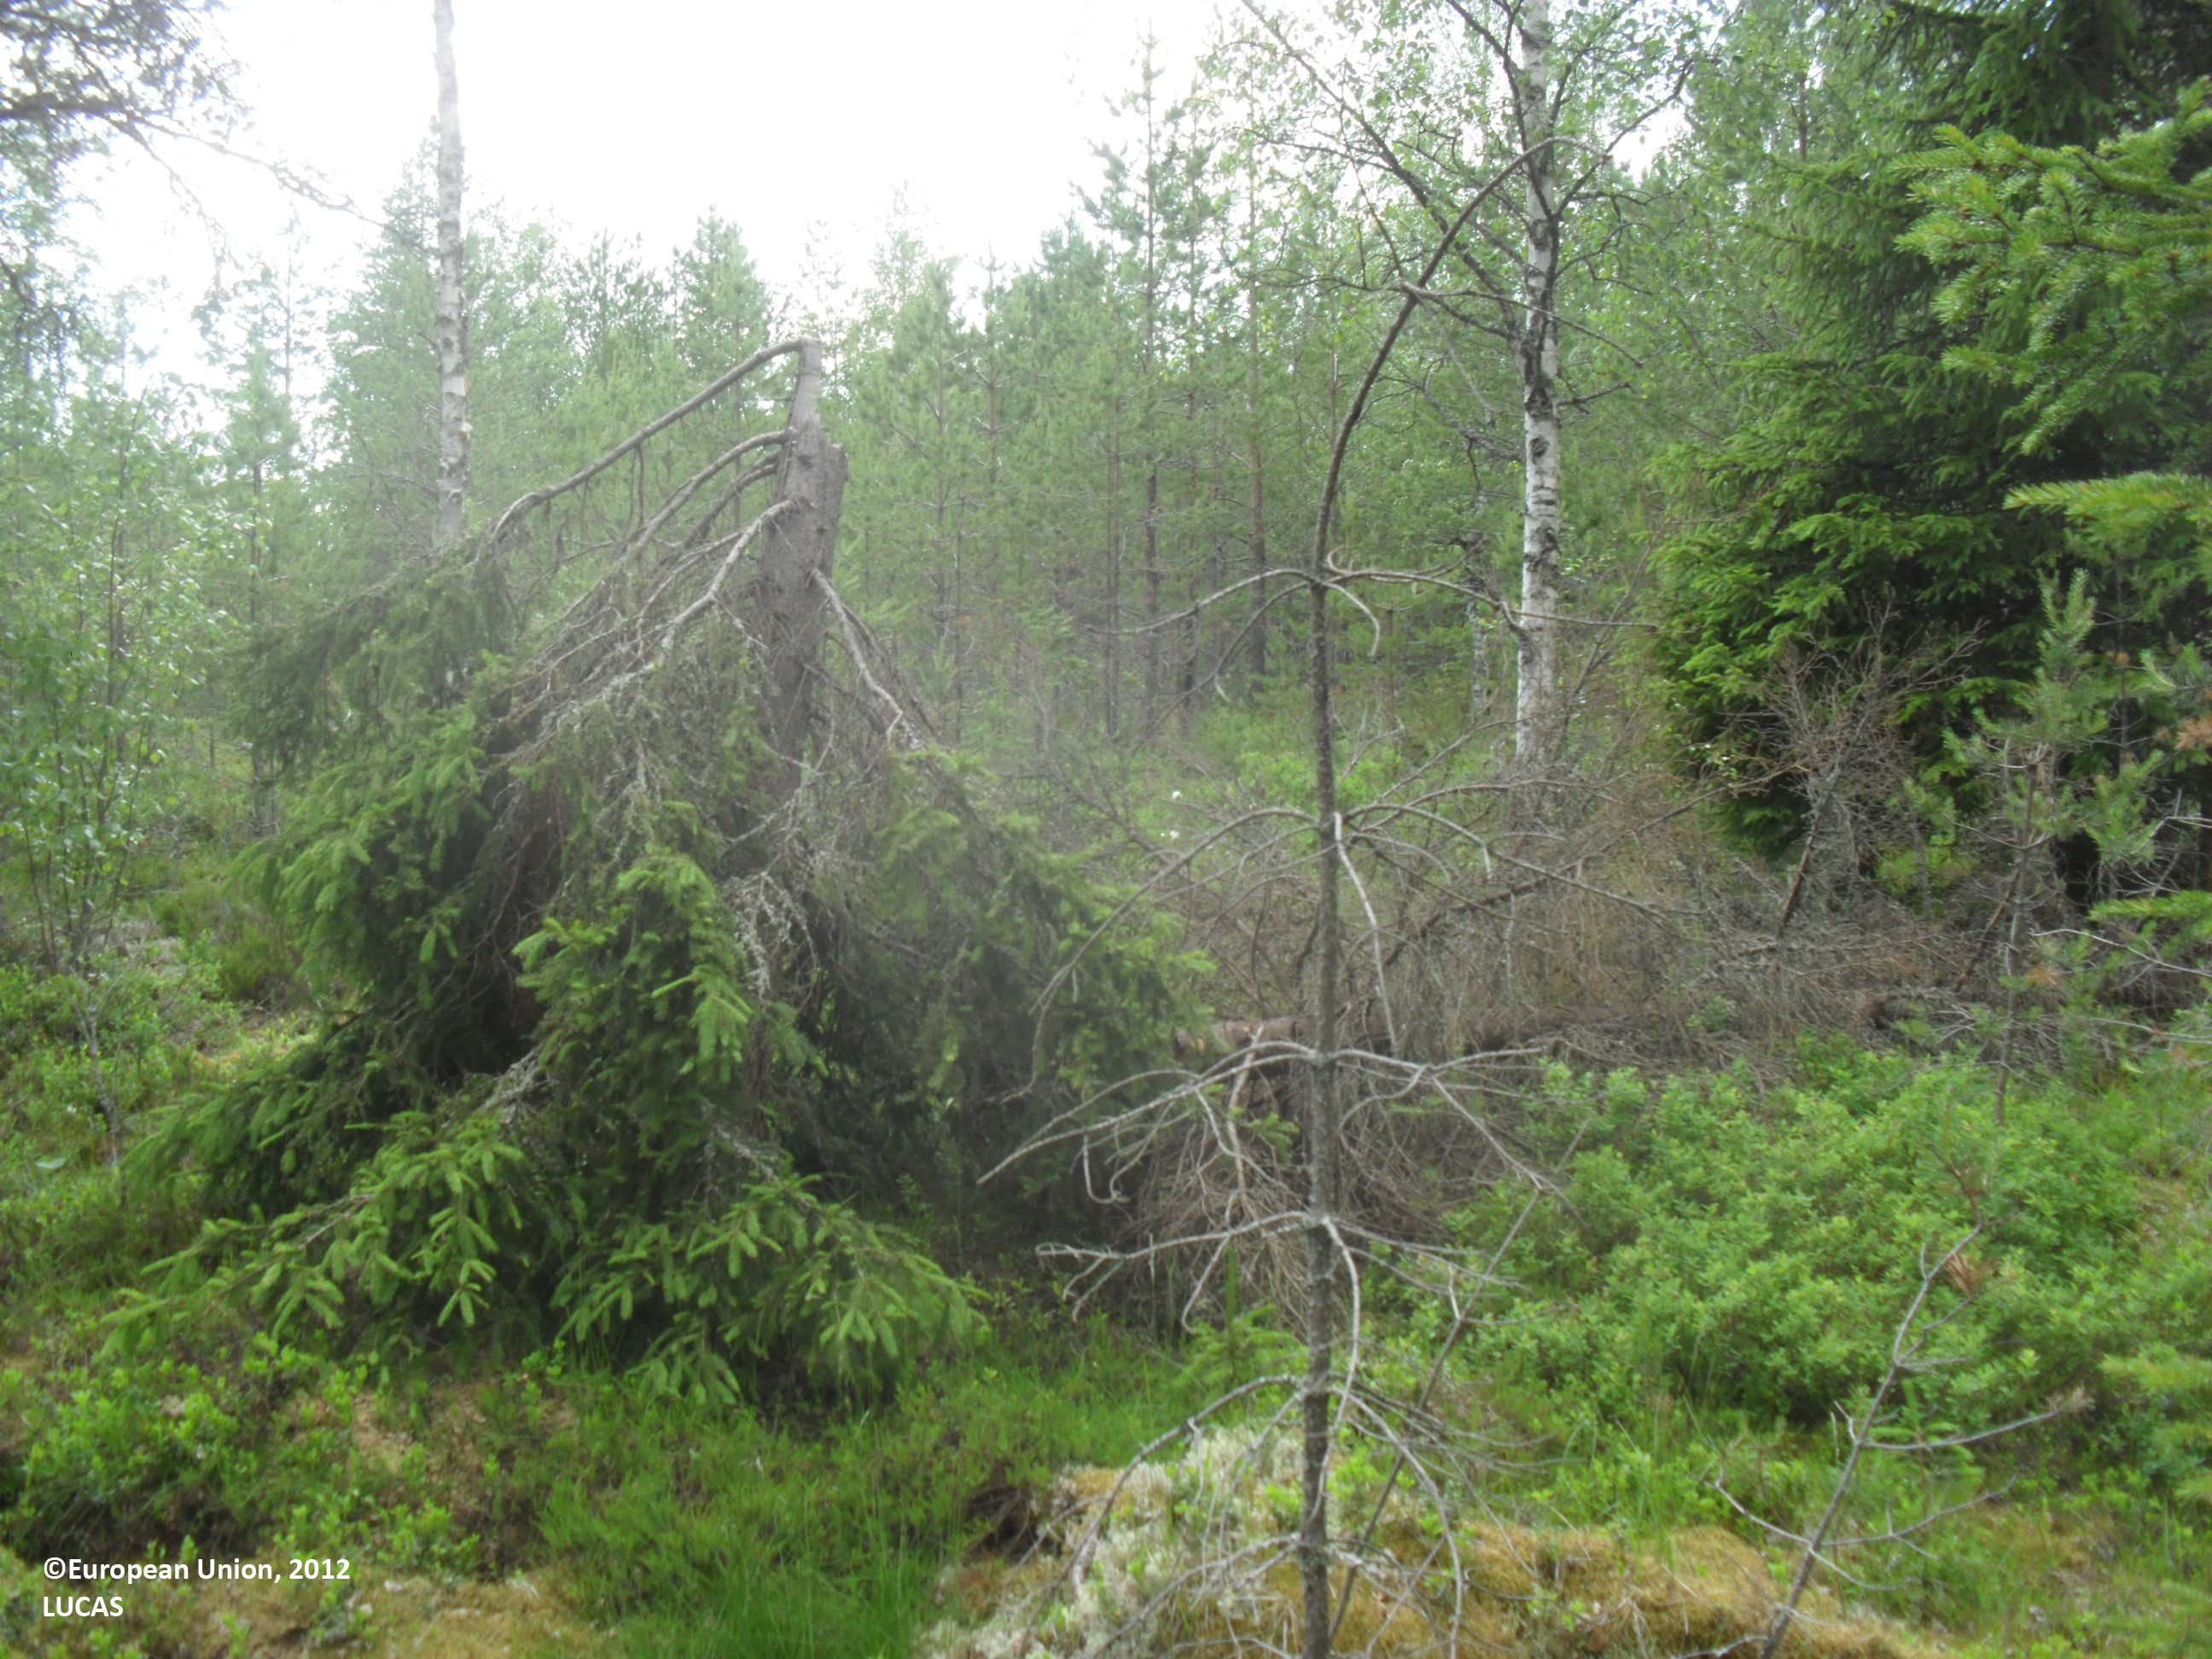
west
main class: Woodland
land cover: Other mixed woodland
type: boreal forest
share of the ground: 25 - 50 %
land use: Forestry
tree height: > 5 m
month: July
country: FI
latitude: 63.4916
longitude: 23.8645
